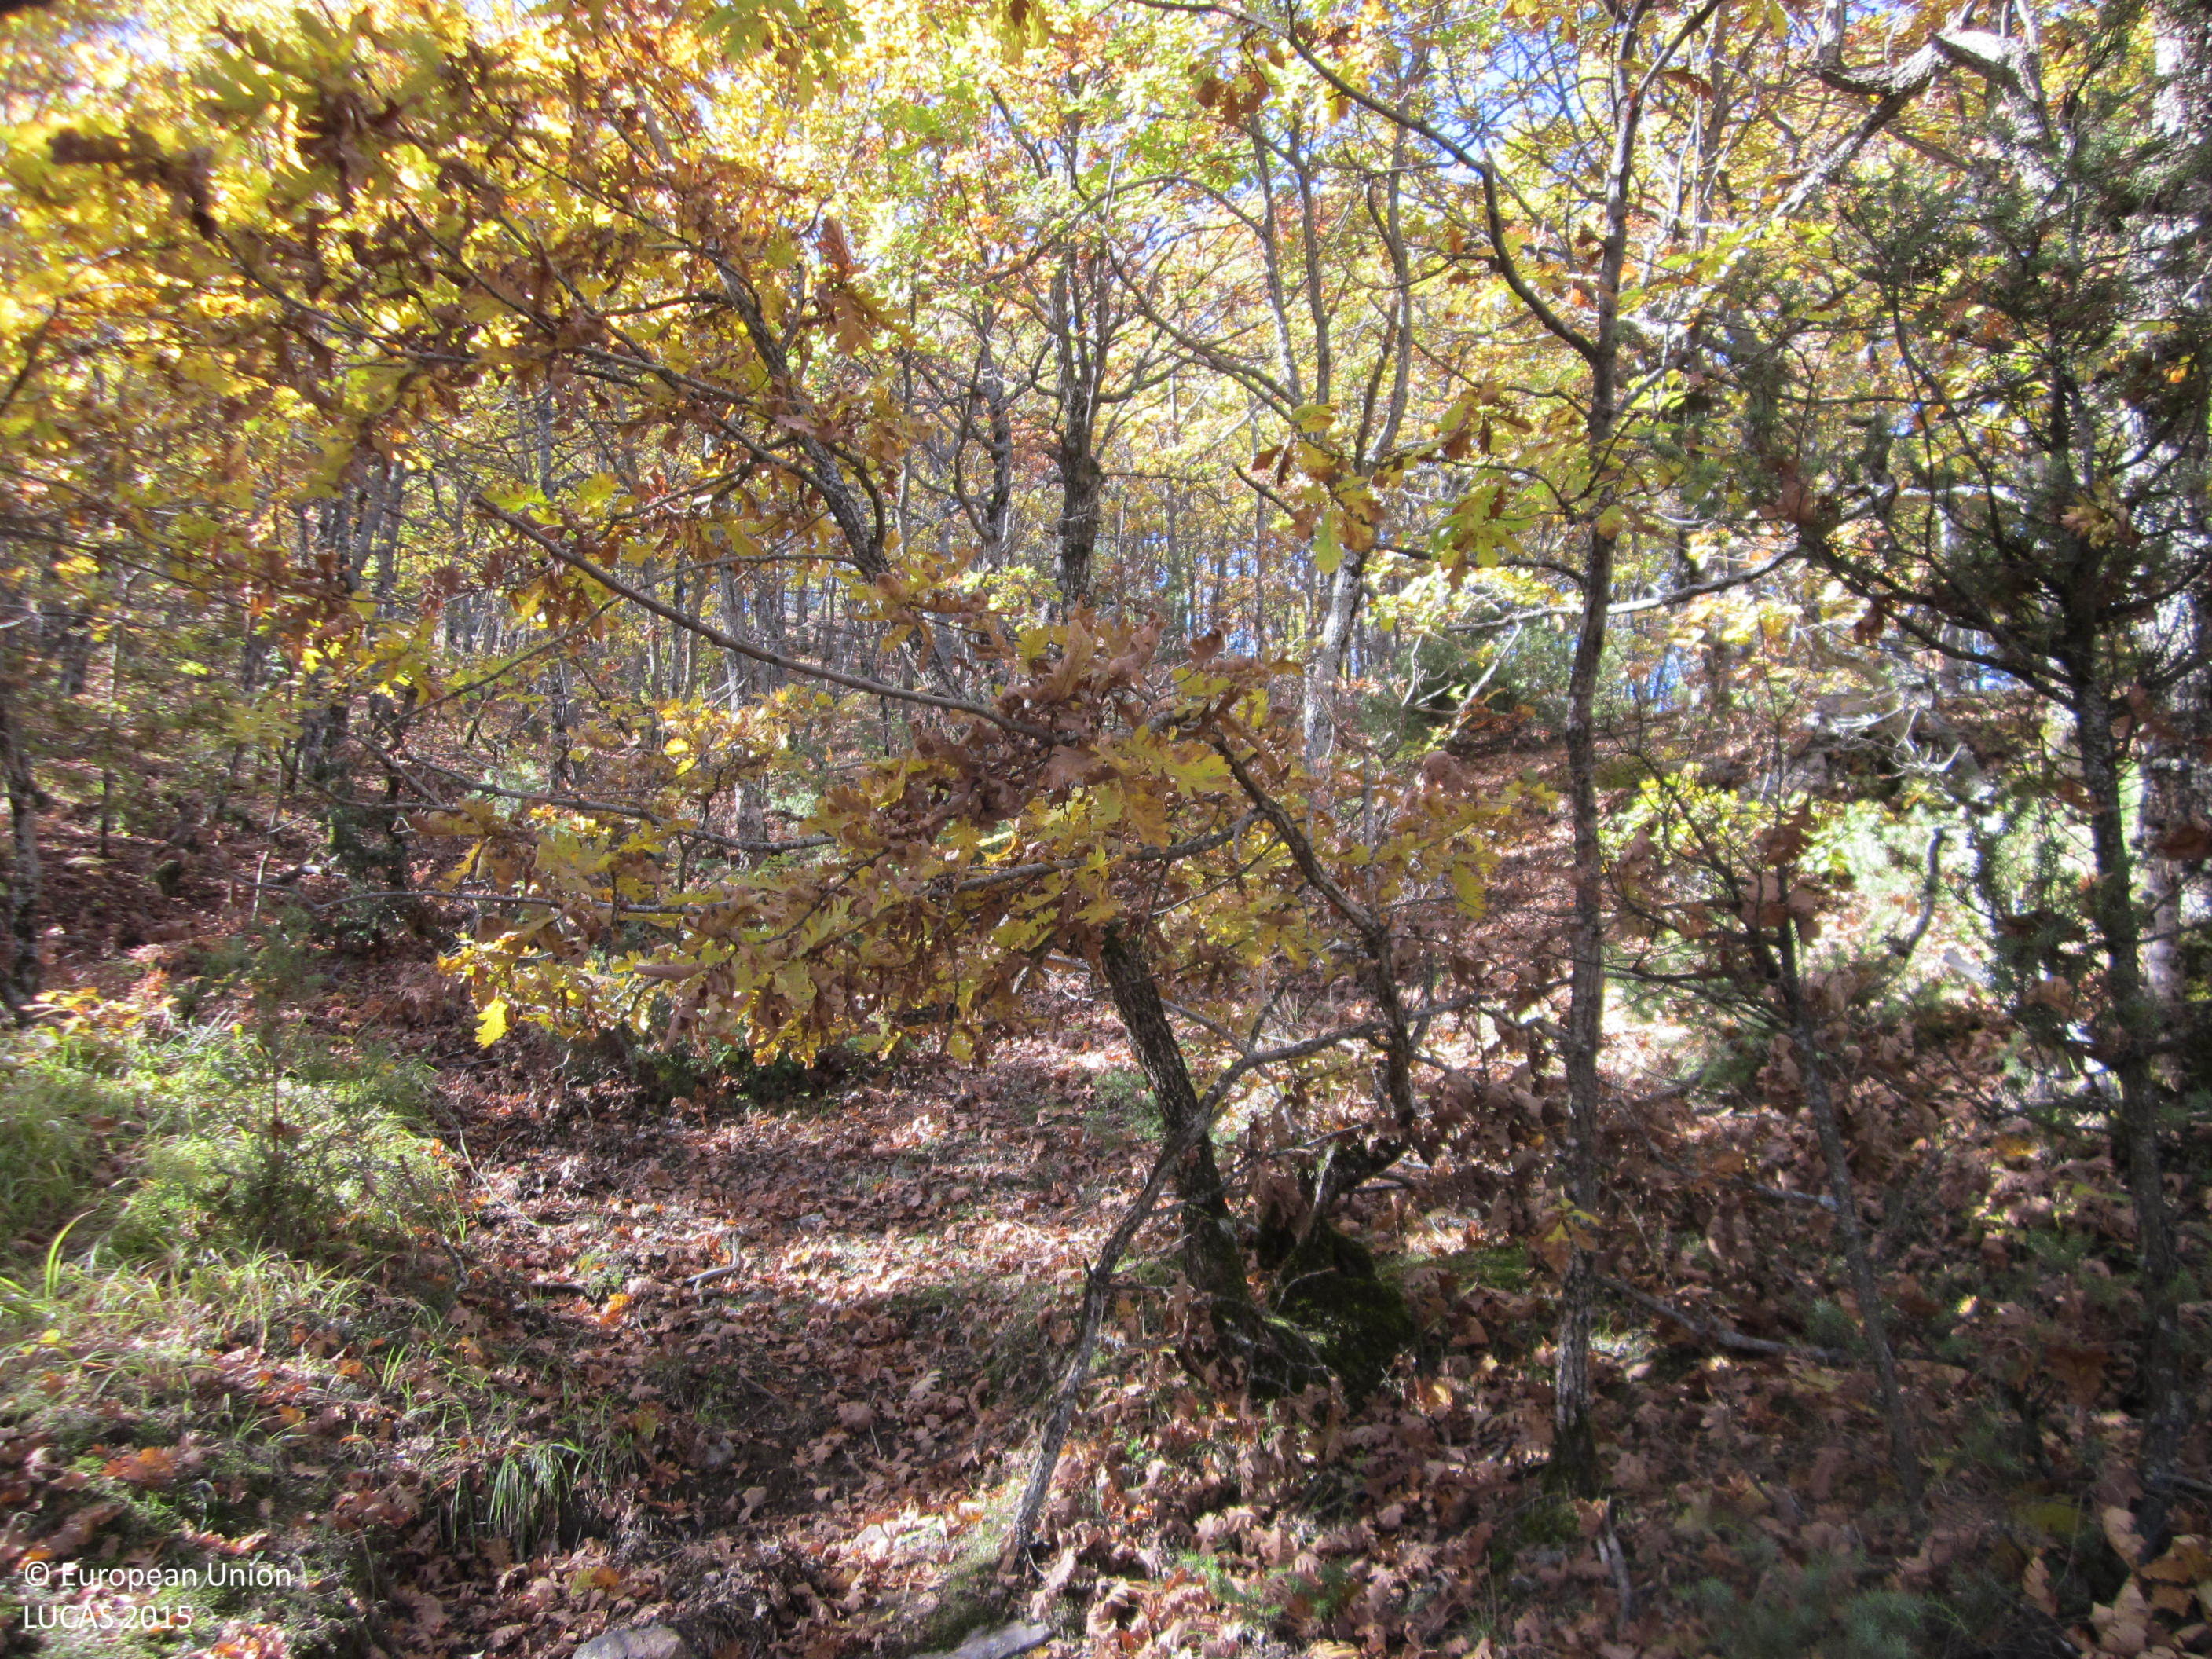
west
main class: Woodland
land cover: Broadleaved woodland
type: mesophytic deciduous forest
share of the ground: > 75 %
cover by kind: broadleaved forest trees 80 %, shrubs 5 %, herbaceous plants 5 %, lichens and mosses 5 %, unconsolidated bare surface 5 %
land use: Forestry
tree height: > 5 m
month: November
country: BG
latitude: 41.3365
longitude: 25.6524
